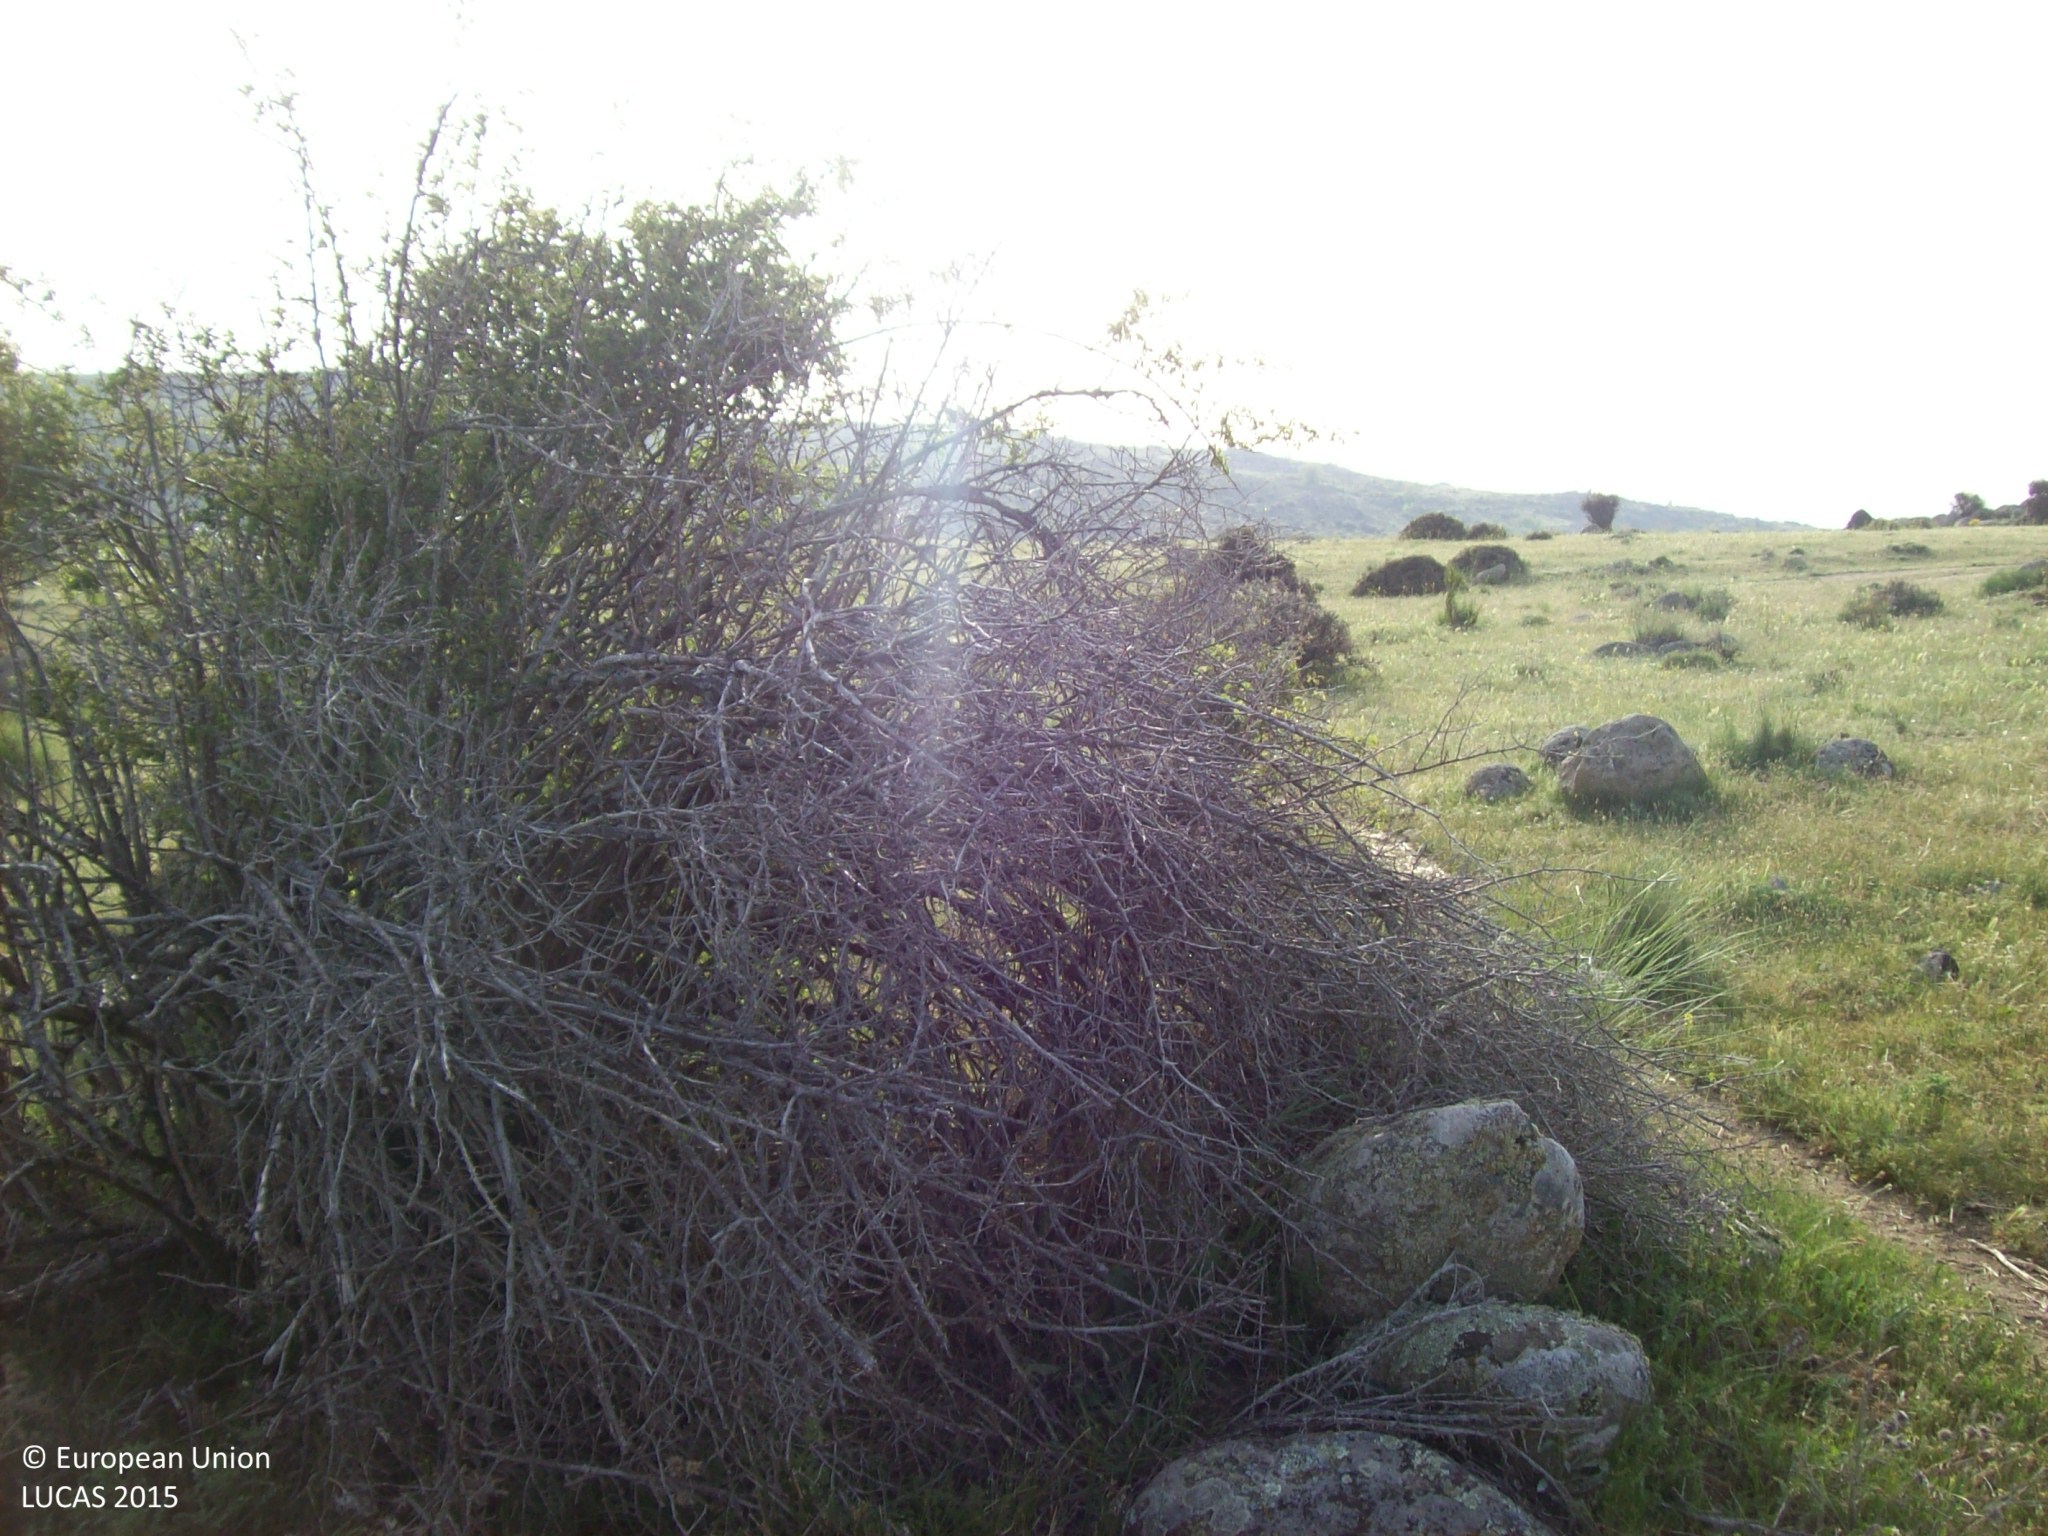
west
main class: Shrubland
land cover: Shrubland without tree cover
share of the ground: 10 - 25 %
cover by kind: herbaceous plants 75 %, shrubs 15 %, consolidated bare surface 10 %
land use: Agriculture (excluding fallow land and kitchen gardens)
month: May
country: ES
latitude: 40.7063
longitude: -4.8660
